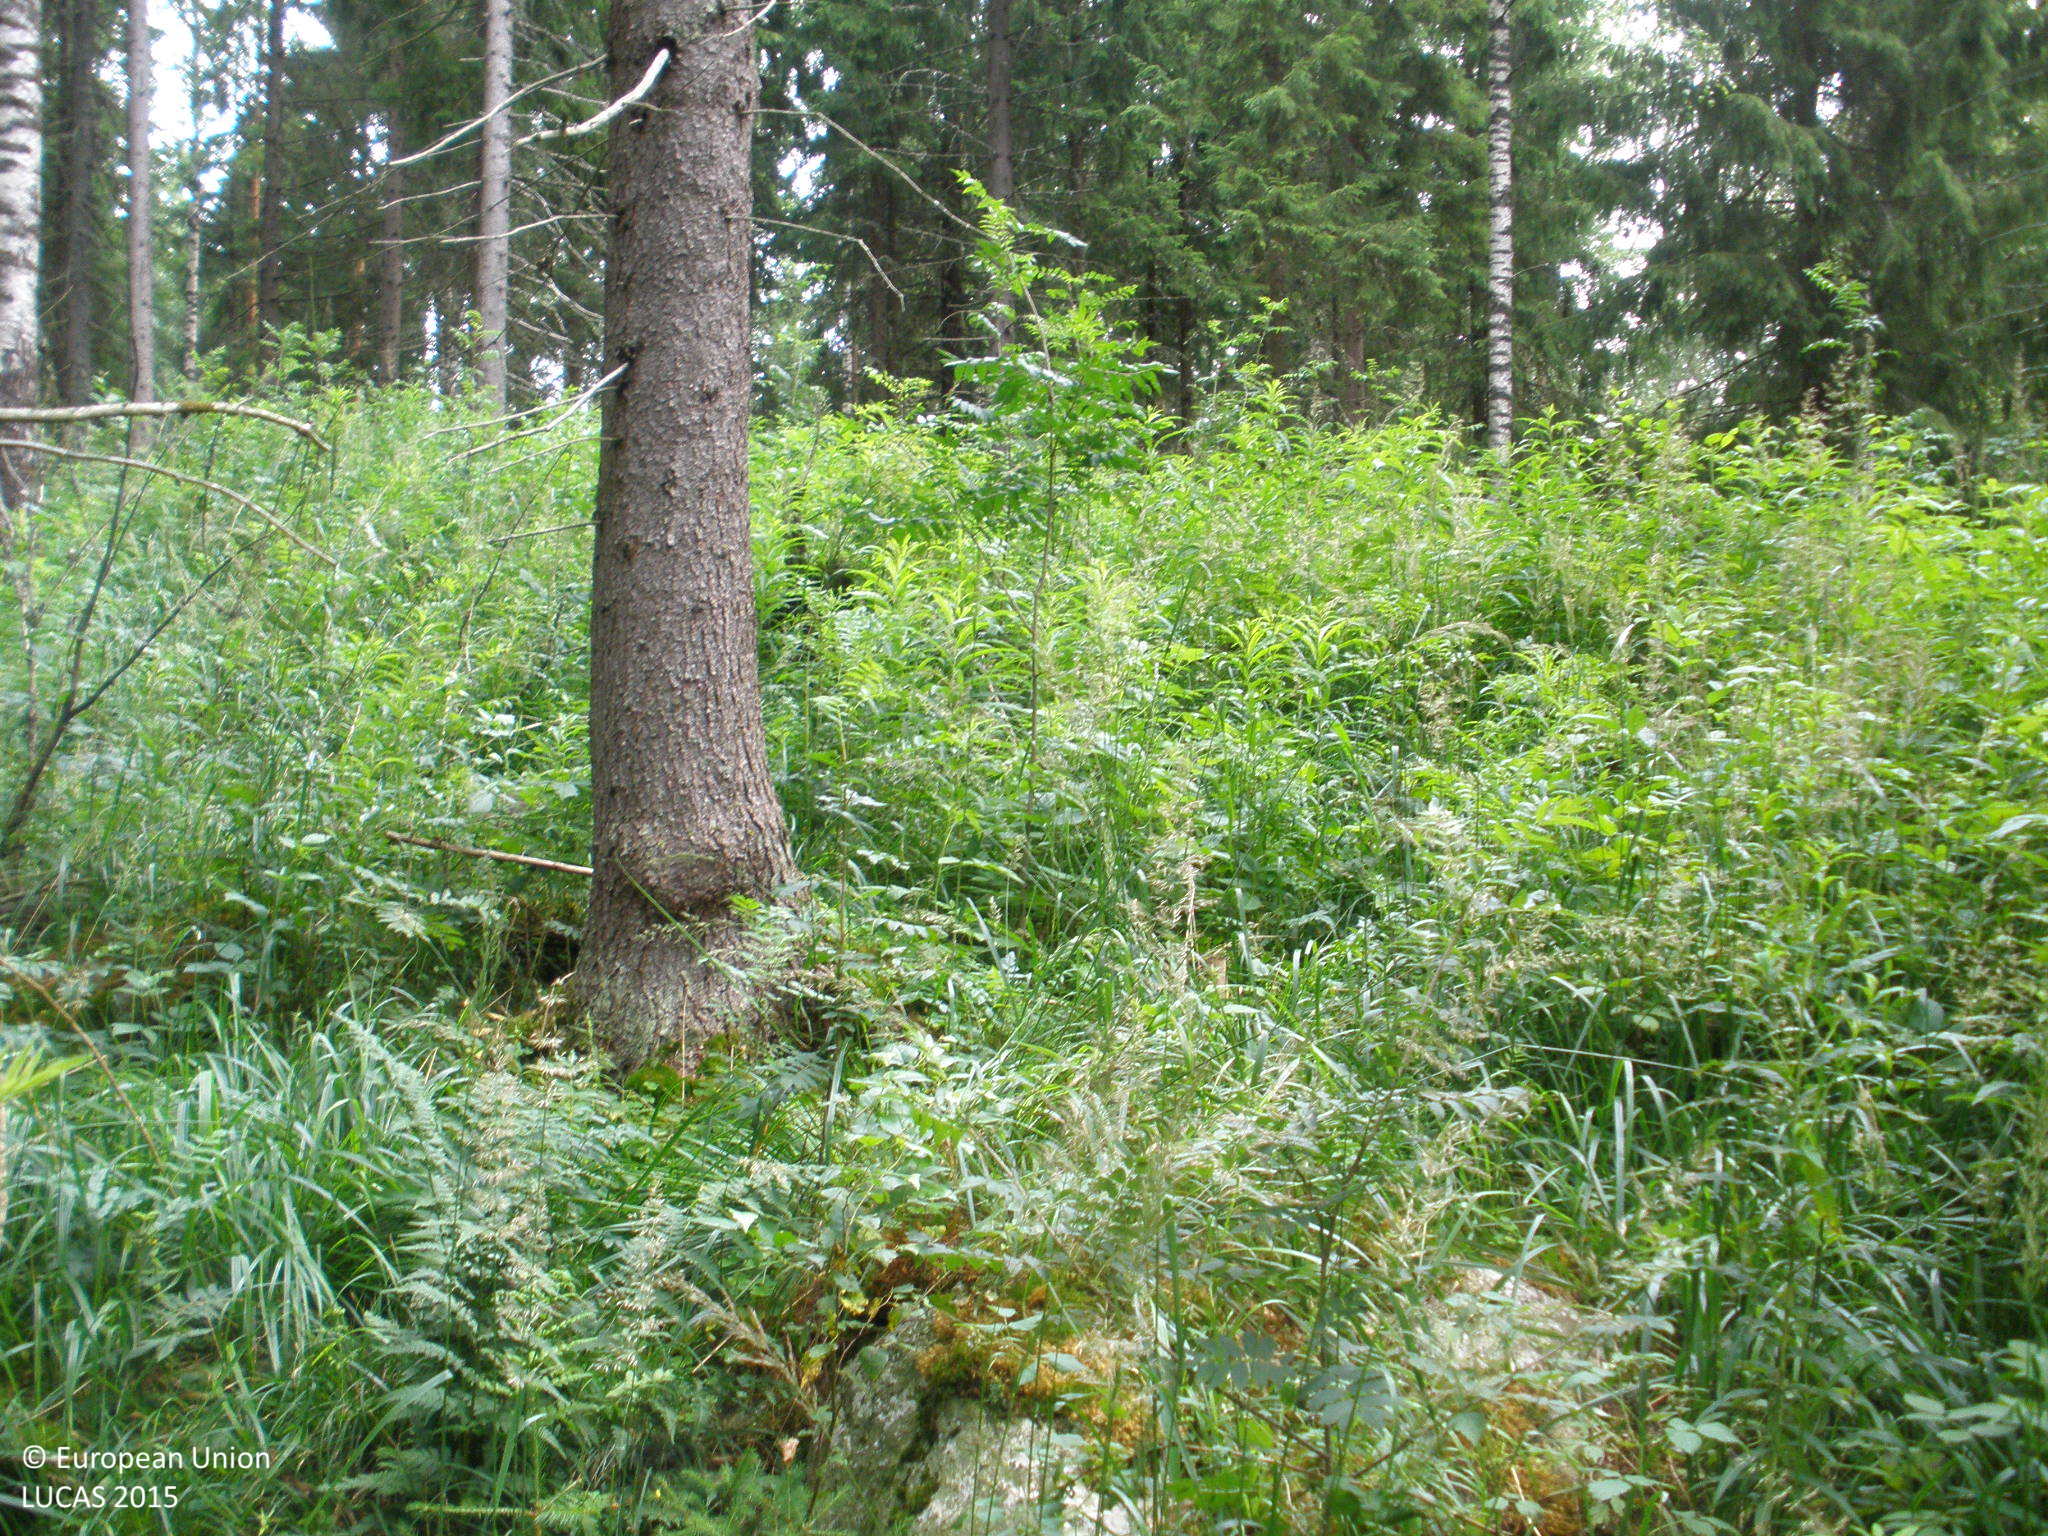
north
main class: Woodland
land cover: Spruce dominated coniferous woodland
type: boreal forest
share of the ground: > 75 %
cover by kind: coniferous forest trees 75 %, shrubs 10 %, herbaceous plants 10 %, broadleaved forest trees 5 %
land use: Forestry
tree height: > 5 m
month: July
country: FI
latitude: 61.1112
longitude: 25.2412
